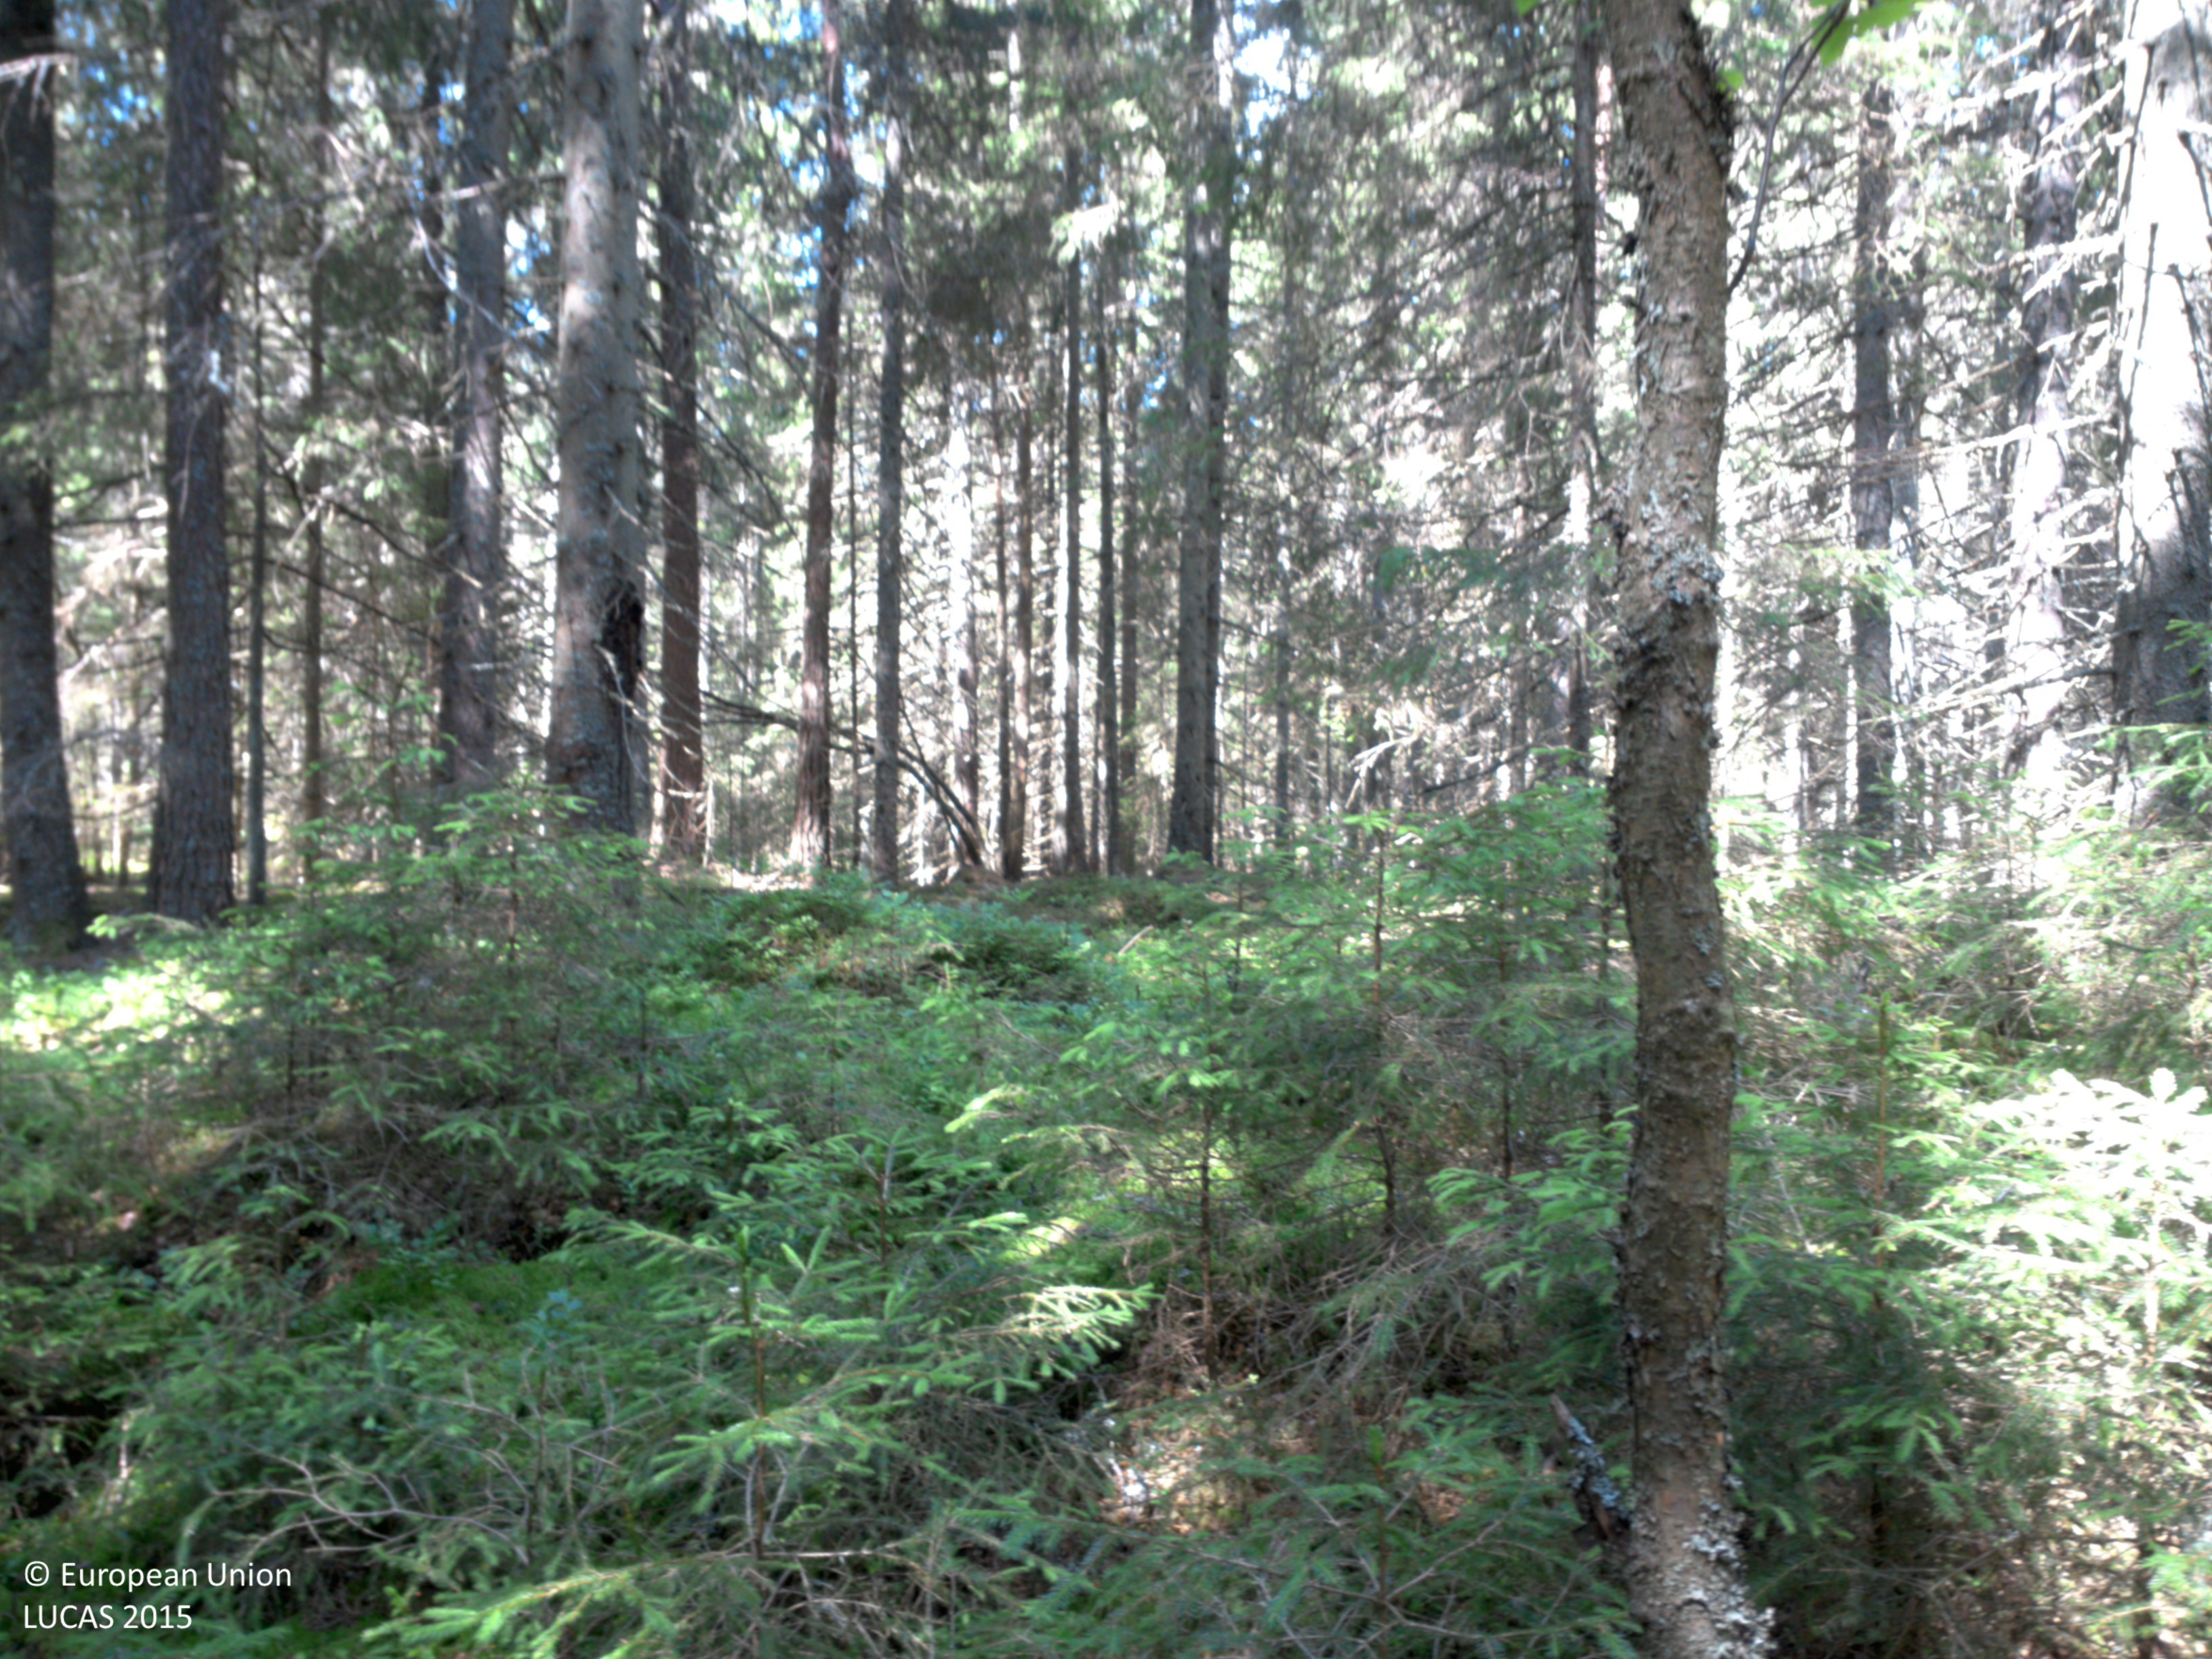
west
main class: Woodland
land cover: Spruce dominated coniferous woodland
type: boreal forest
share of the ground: 50 - 75 %
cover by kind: coniferous forest trees 75 %, lichens and mosses 25 %
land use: Forestry
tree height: > 5 m
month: July
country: SE
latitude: 58.8001
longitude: 11.8822
